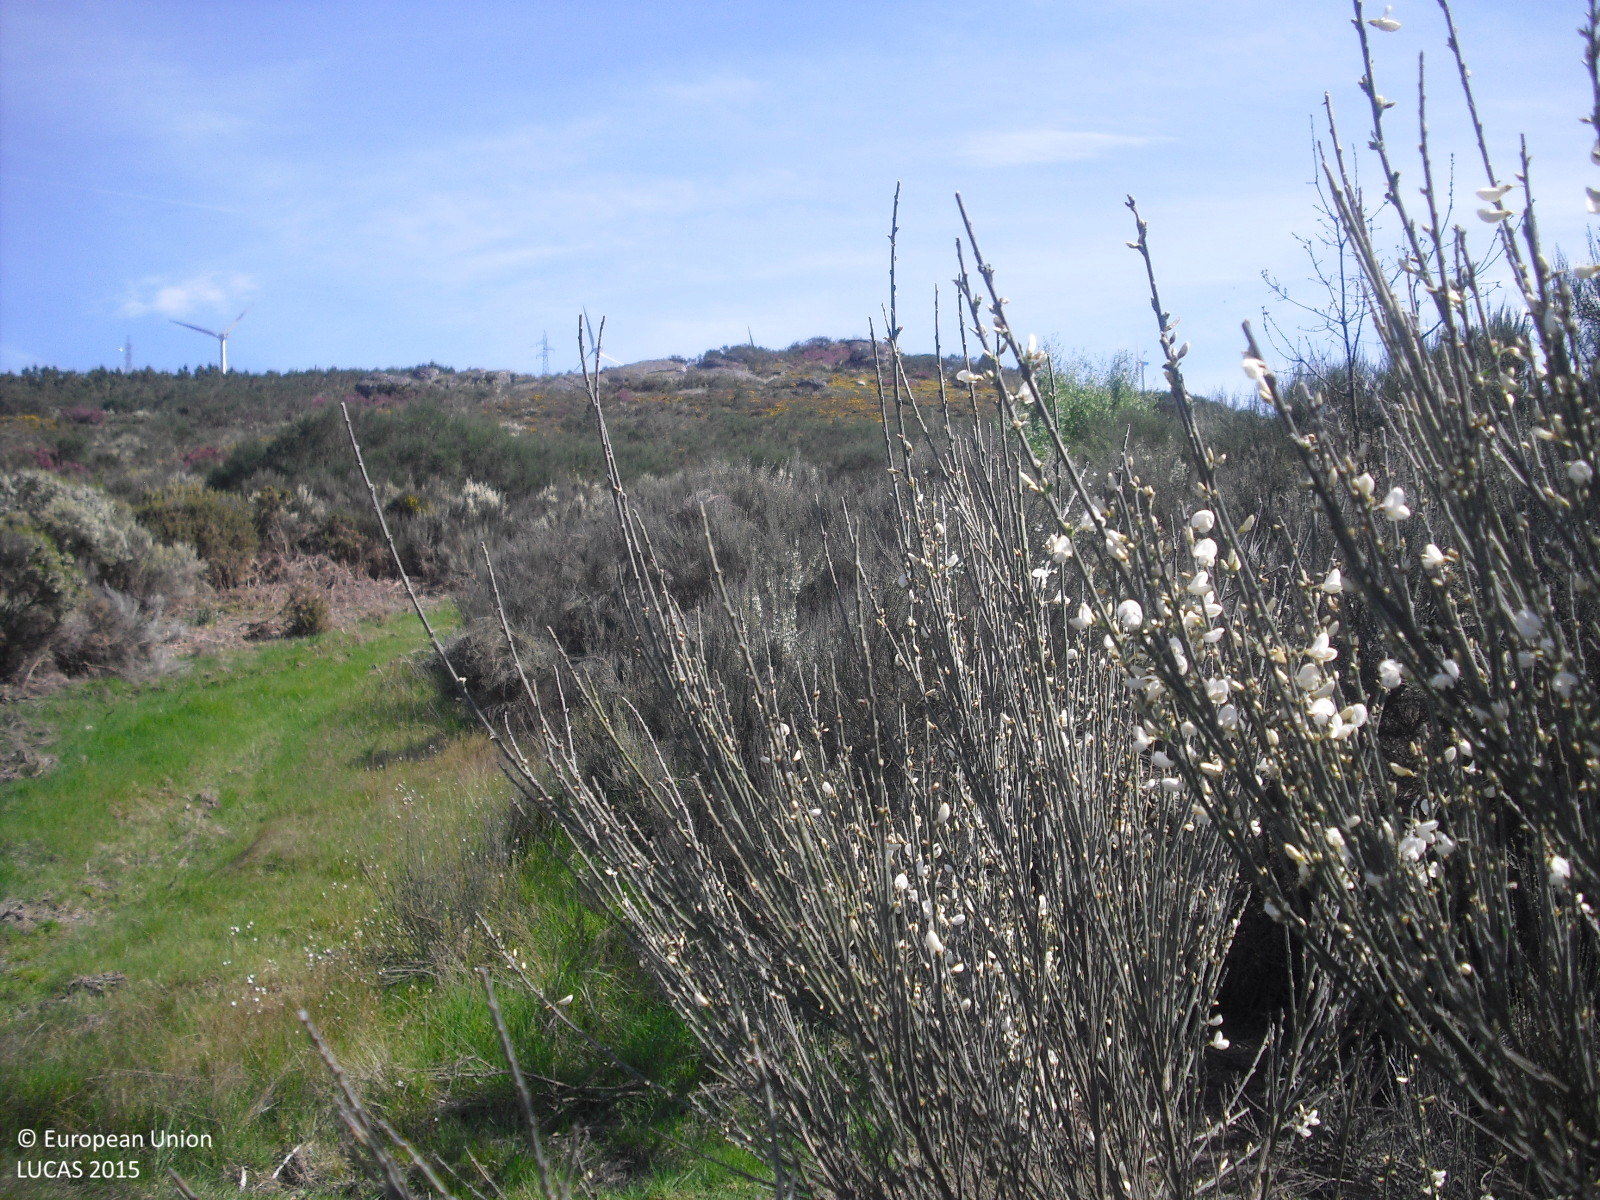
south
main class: Artificial land
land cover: Non built-up linear features
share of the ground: > 75 %
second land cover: Grassland without tree/shrub cover
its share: > 75 %
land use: Road transport
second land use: Agriculture (excluding fallow land and kitchen gardens)
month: April
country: ES
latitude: 41.9574
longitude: -7.6441
